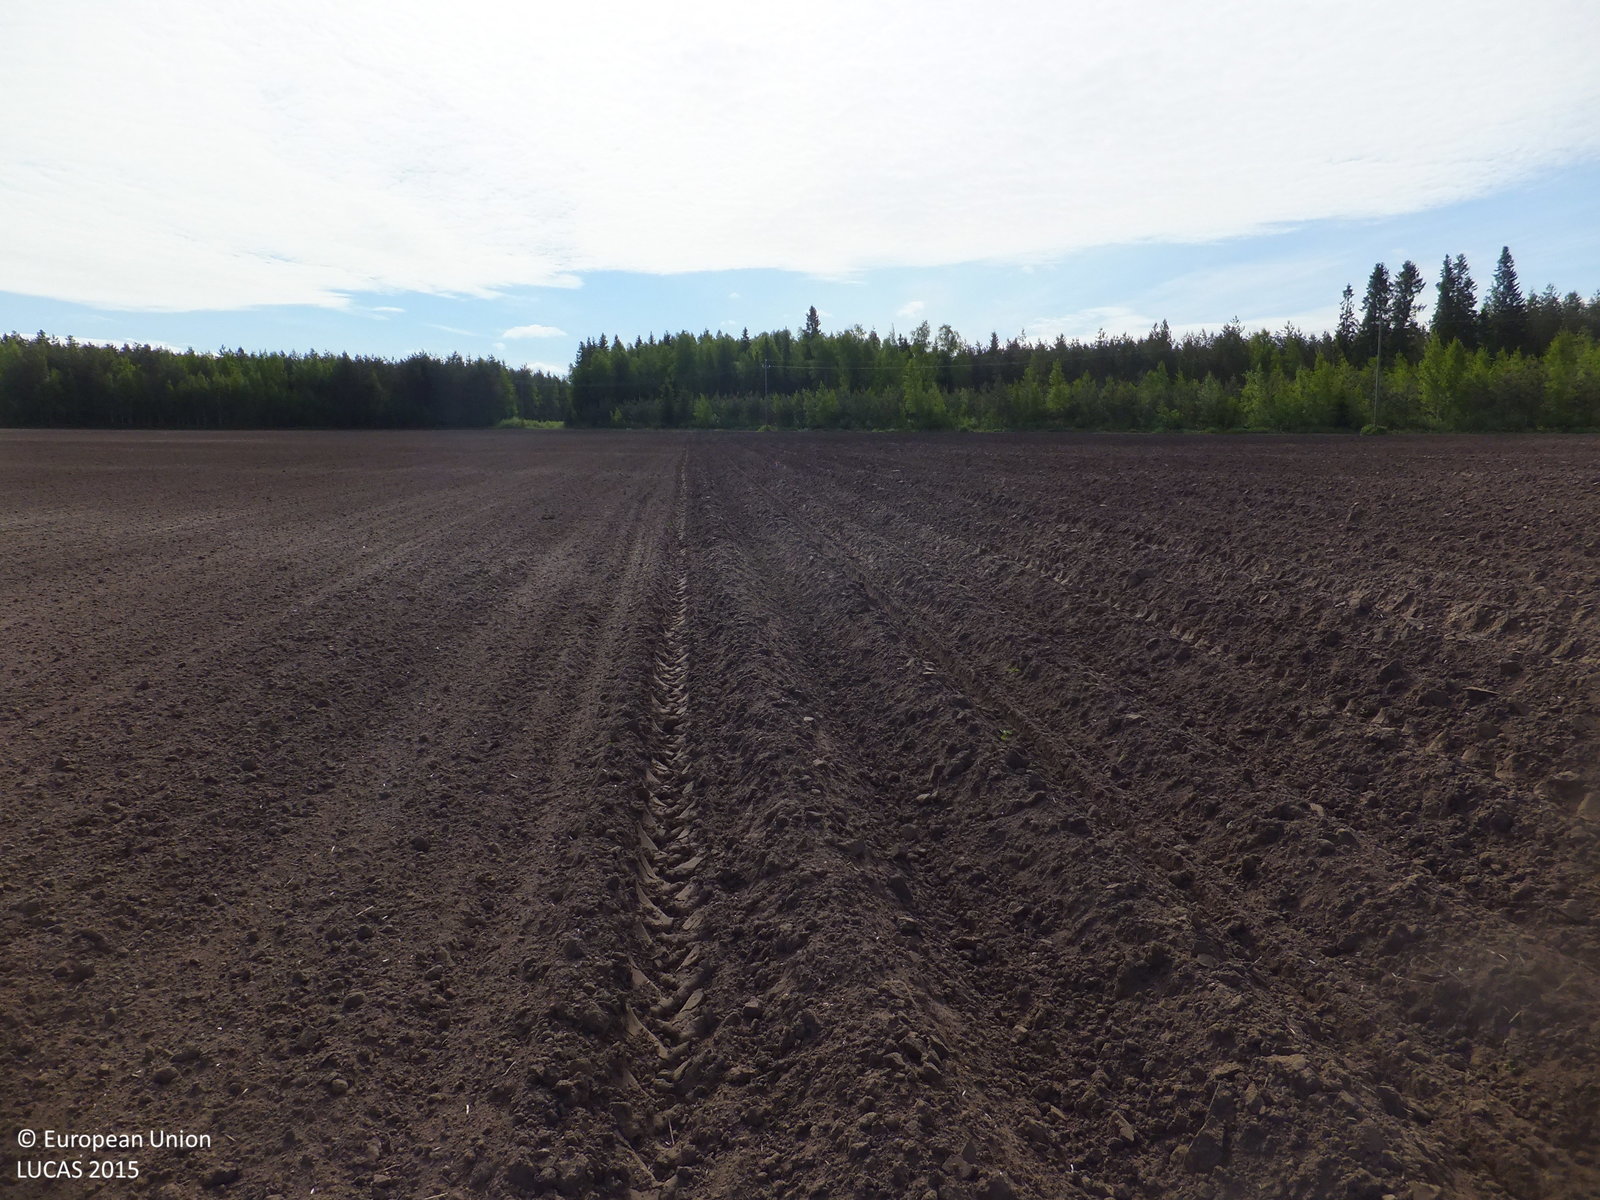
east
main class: Cropland
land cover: Barley
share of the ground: < 10 %
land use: Agriculture (excluding fallow land and kitchen gardens)
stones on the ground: < 10 %
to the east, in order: Barley; Grass margins; Ditches and canals; Pine dominated mixed woodland
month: June
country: FI
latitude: 63.3892
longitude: 22.7177
